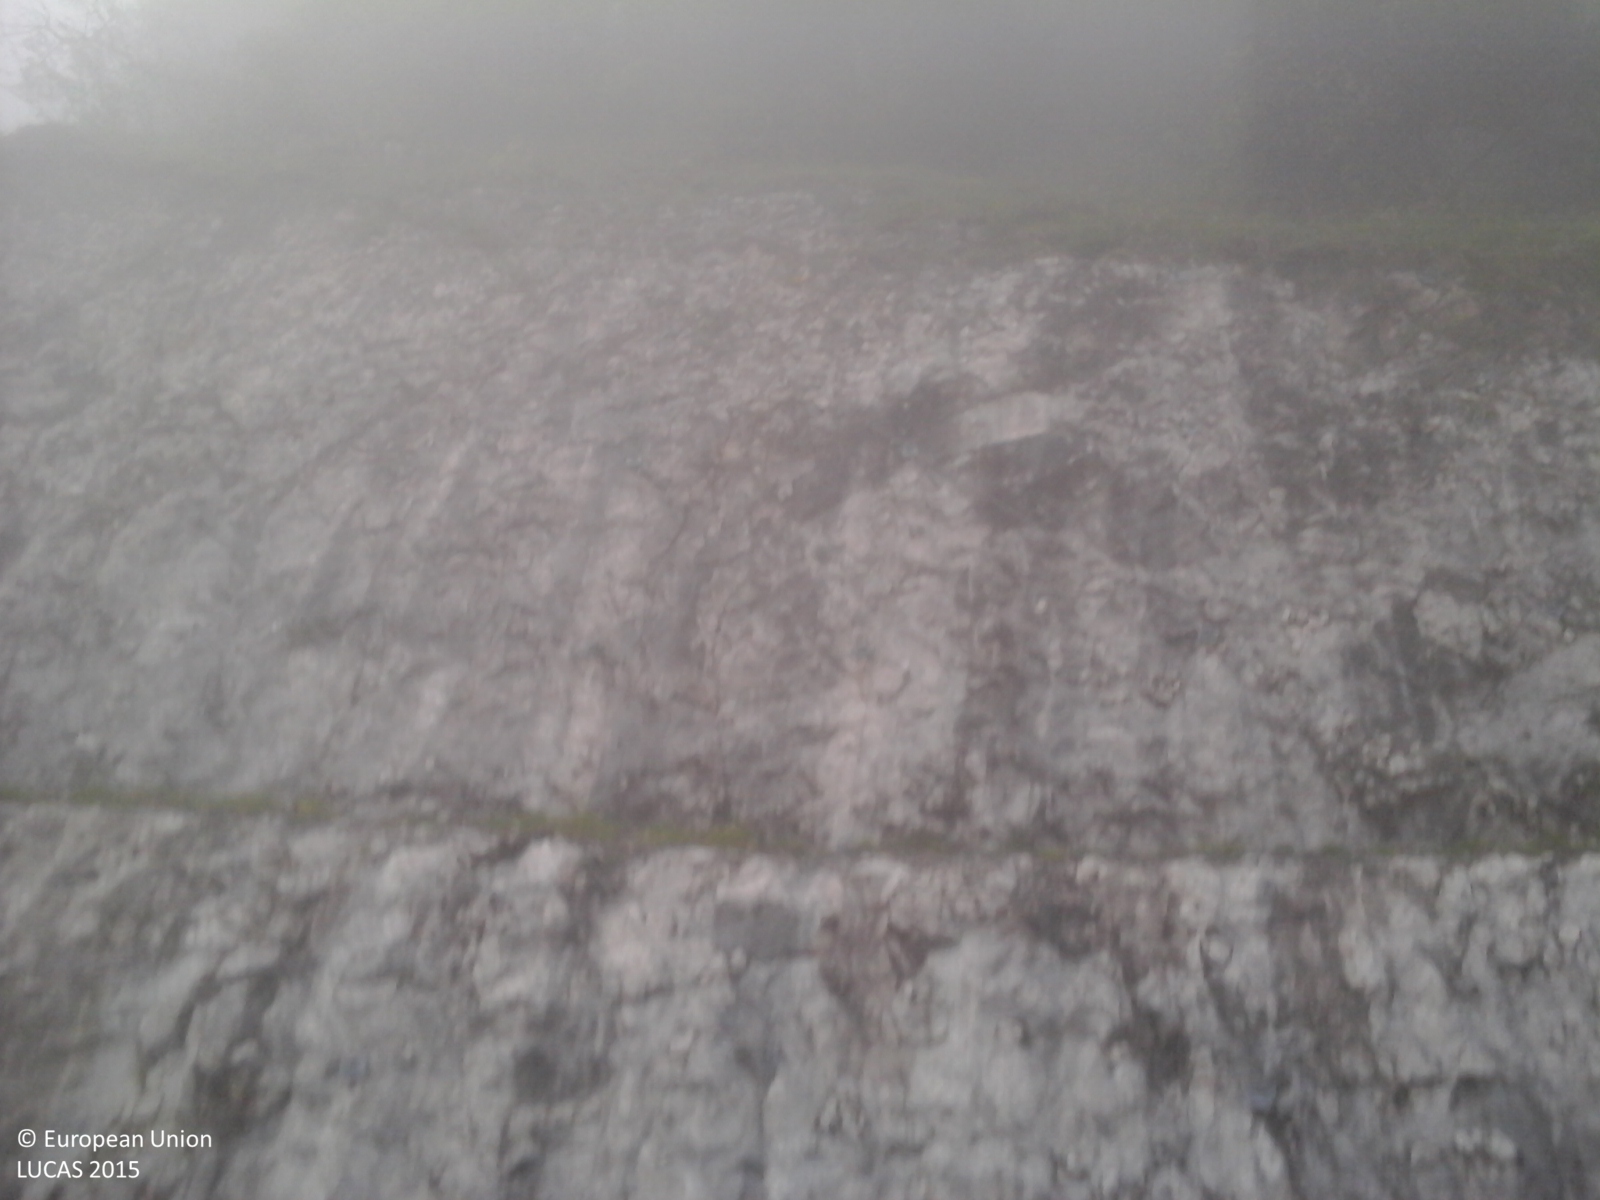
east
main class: Woodland
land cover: Other coniferous woodland
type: alpine coniferous forest
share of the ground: > 75 %
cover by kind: coniferous forest trees 80 %, herbaceous plants 20 %
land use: Forestry
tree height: > 5 m
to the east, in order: Other coniferous woodland; Paved roads, cycling and walking lanes; Electric lines; Paved roads, cycling and walking lanes
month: May
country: IT
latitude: 46.1044
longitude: 11.6407
